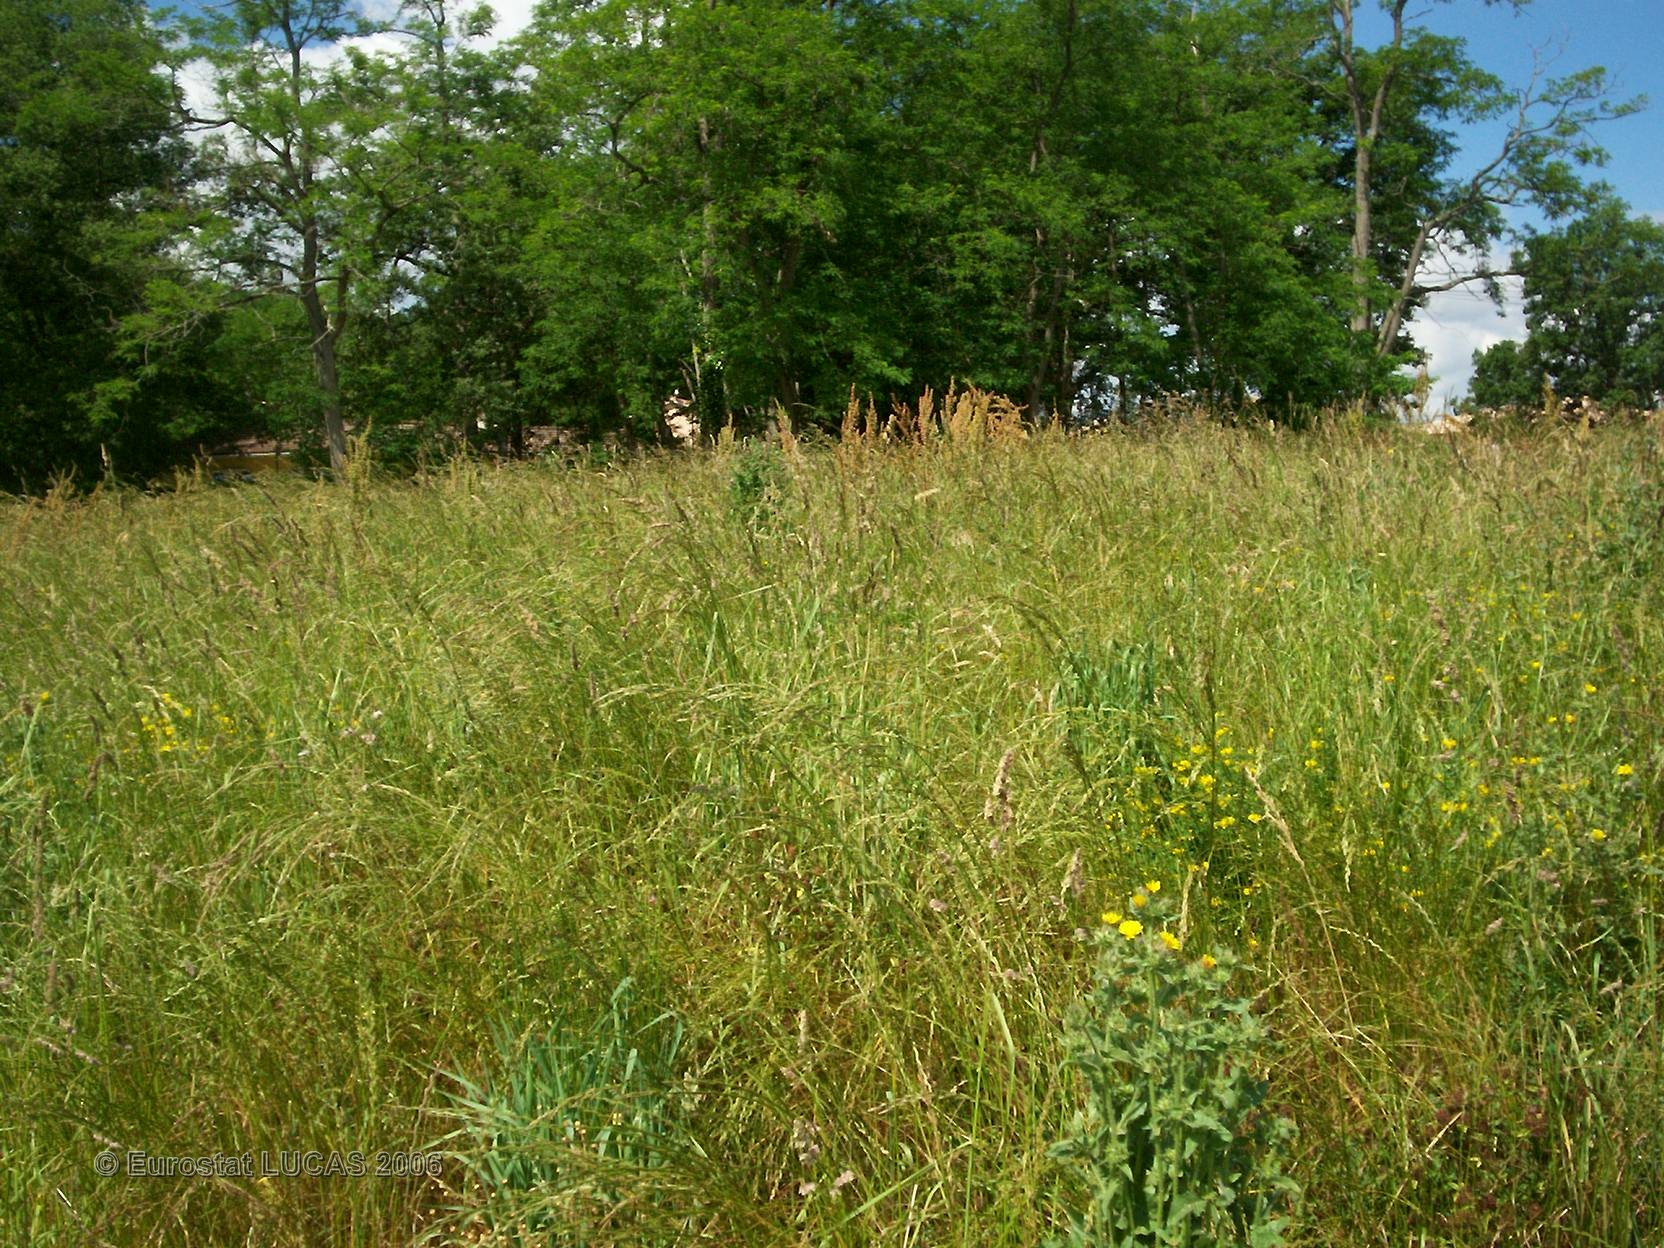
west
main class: Grassland
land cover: Grassland without tree/shrub cover
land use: Agriculture (excluding fallow land and kitchen gardens)
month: May
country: FR
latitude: 43.5397
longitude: 0.9788
